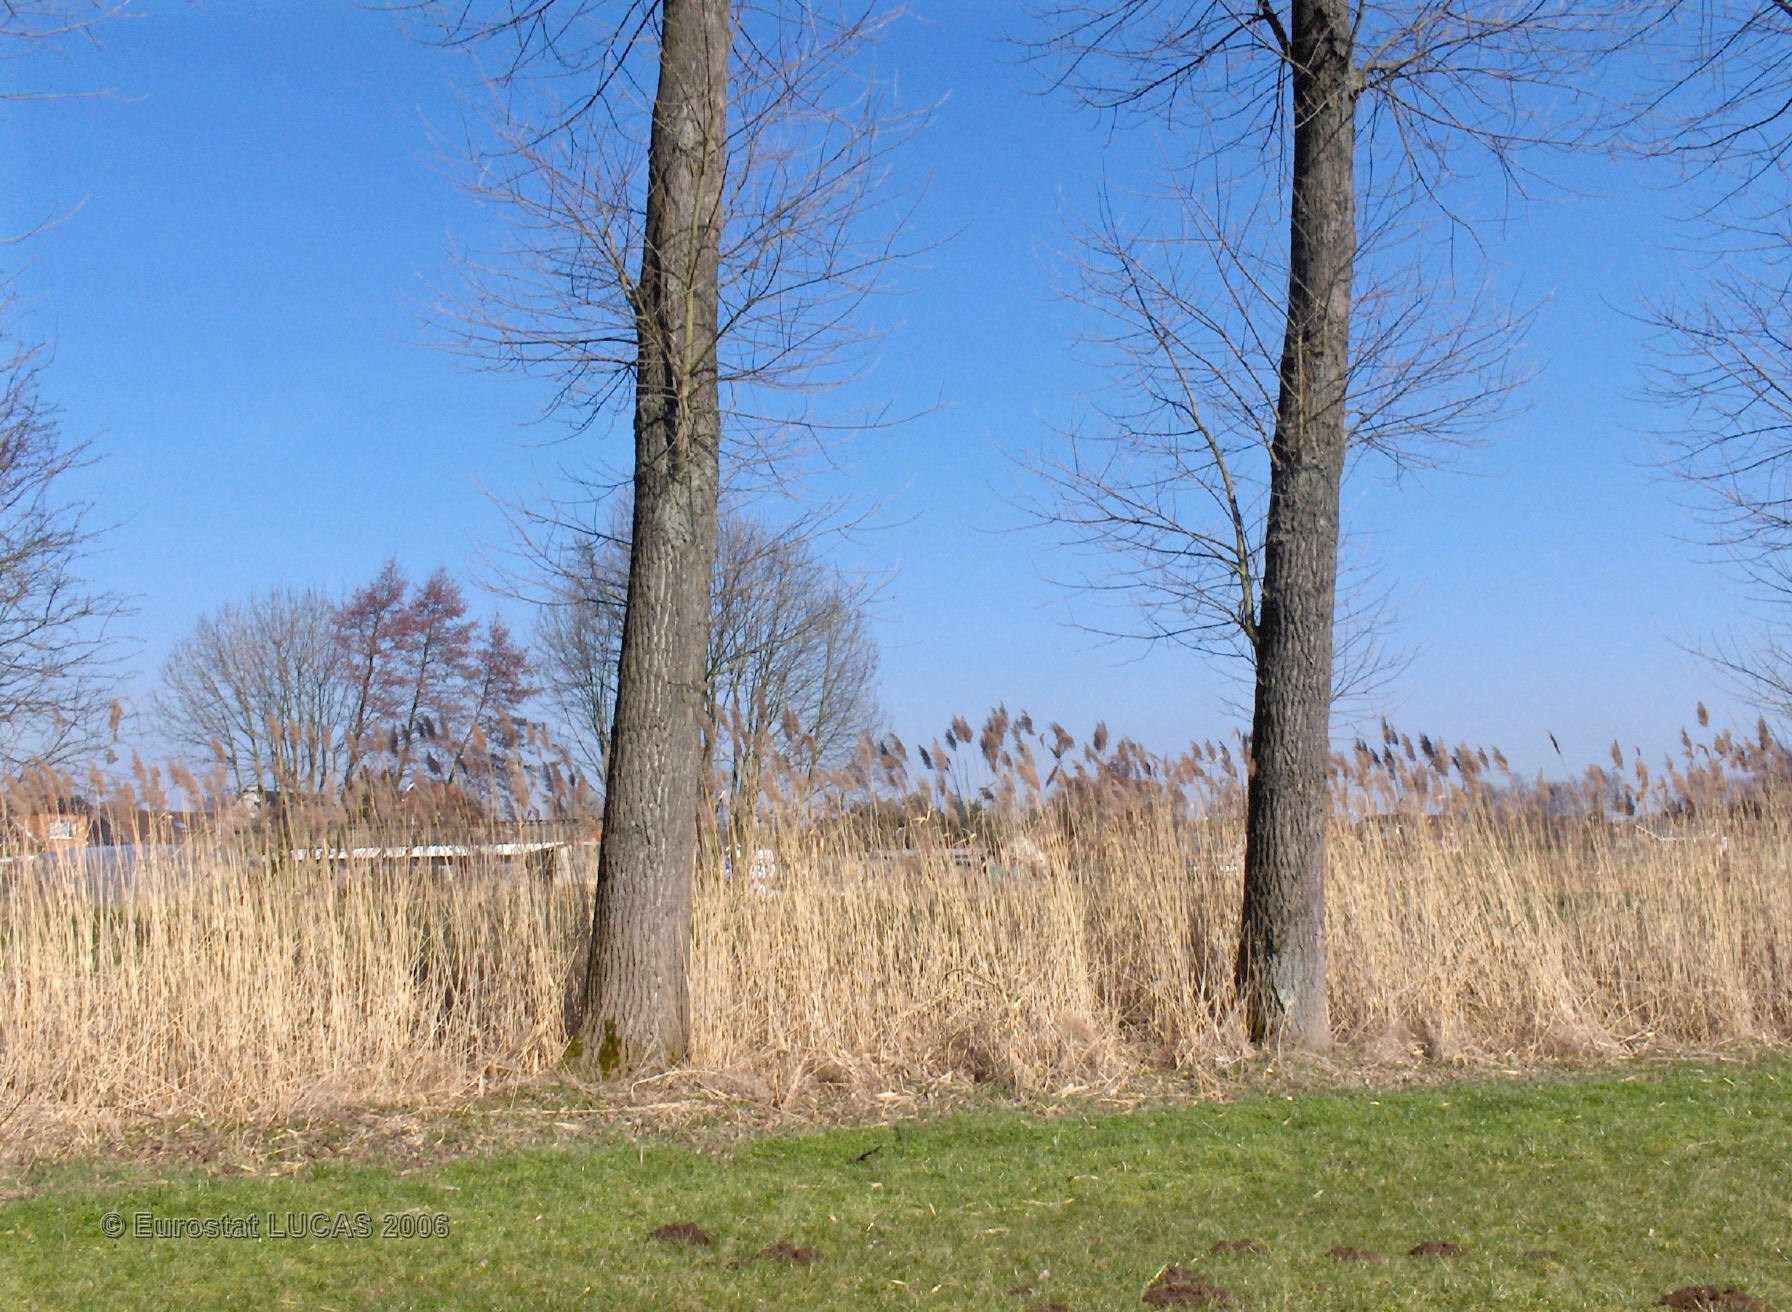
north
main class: Grassland
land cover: Grassland without tree/shrub cover
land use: Agriculture (excluding fallow land and kitchen gardens)
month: March
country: BE
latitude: 50.9669
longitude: 5.2273
